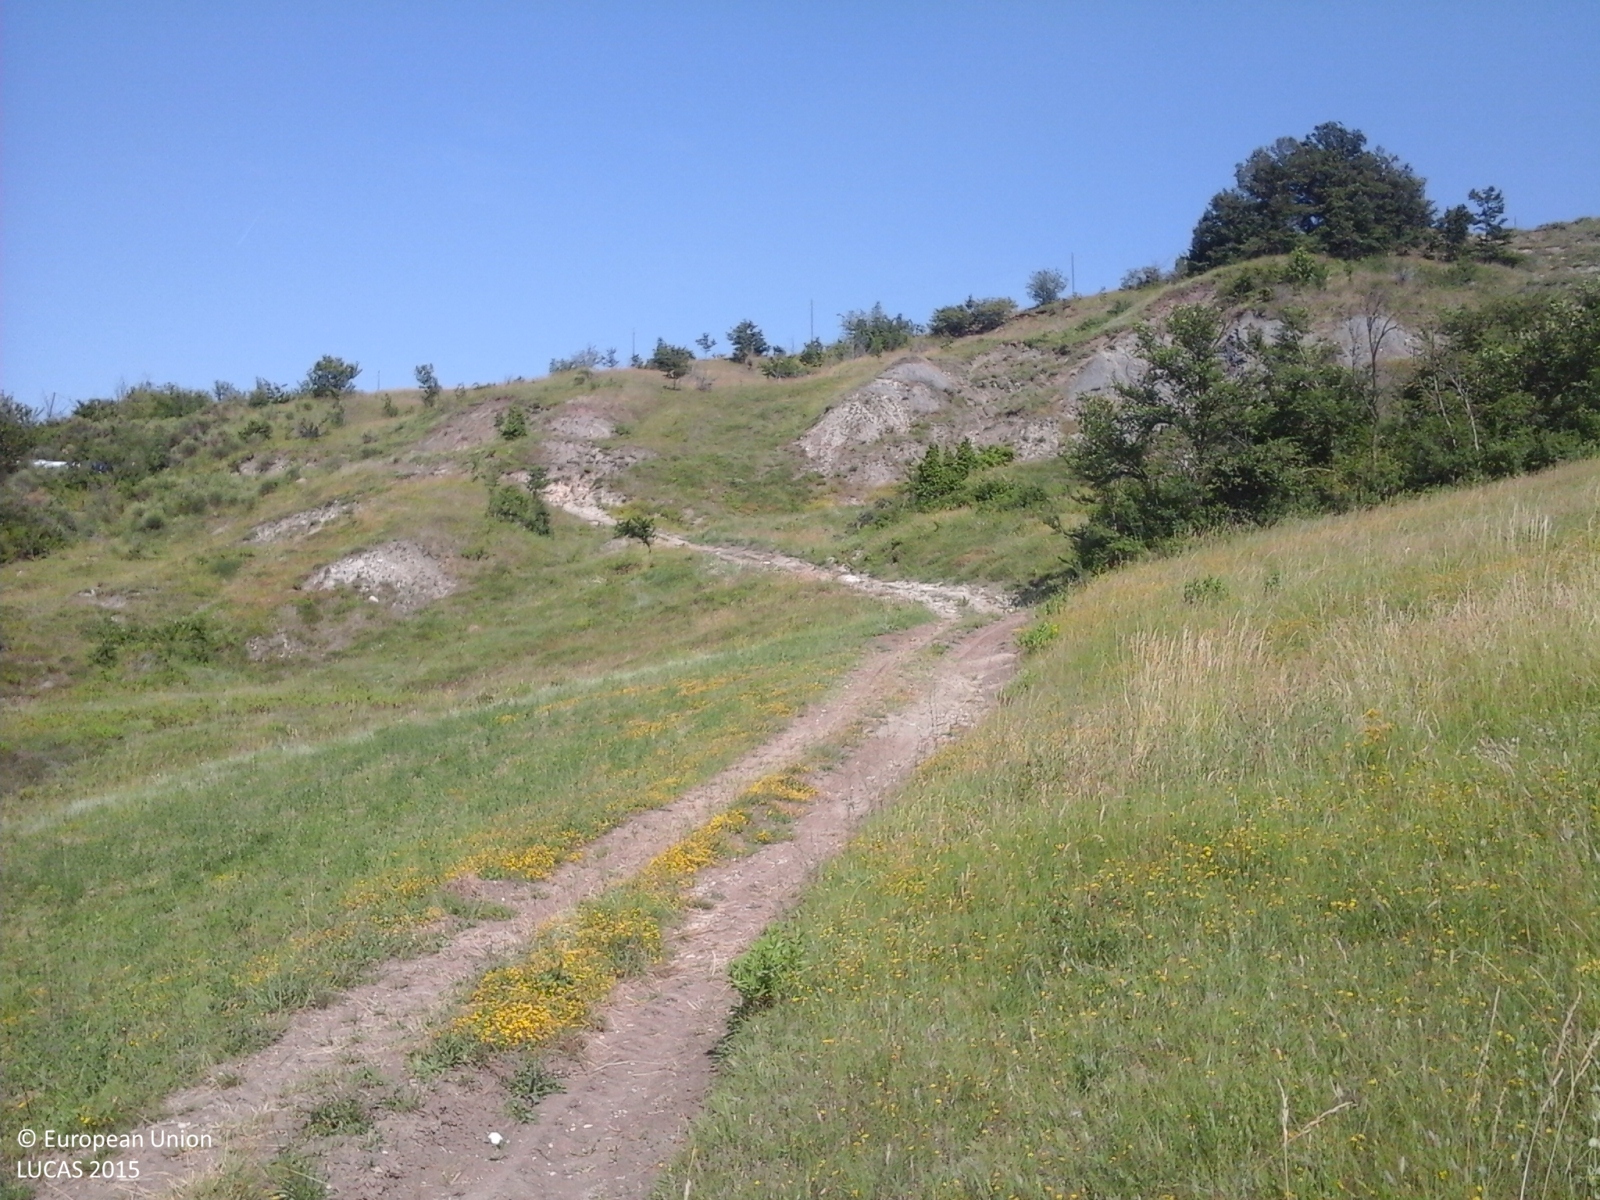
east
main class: Grassland
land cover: Grassland without tree/shrub cover
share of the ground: > 75 %
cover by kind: herbaceous plants 100 %
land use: Agriculture (excluding fallow land and kitchen gardens)
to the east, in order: Grassland without tree/shrub cover; Tracks; Grassland without tree/shrub cover; Grassland with sparse tree/shrub cover; Tracks; Rocks and stones; Grassland with sparse tree/shrub cover; Electric lines; Grassland with sparse tree/shrub cover; Tracks; Managed hedges; Spontaneously vegetated surfaces
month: June
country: IT
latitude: 44.5484
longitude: 10.3391
